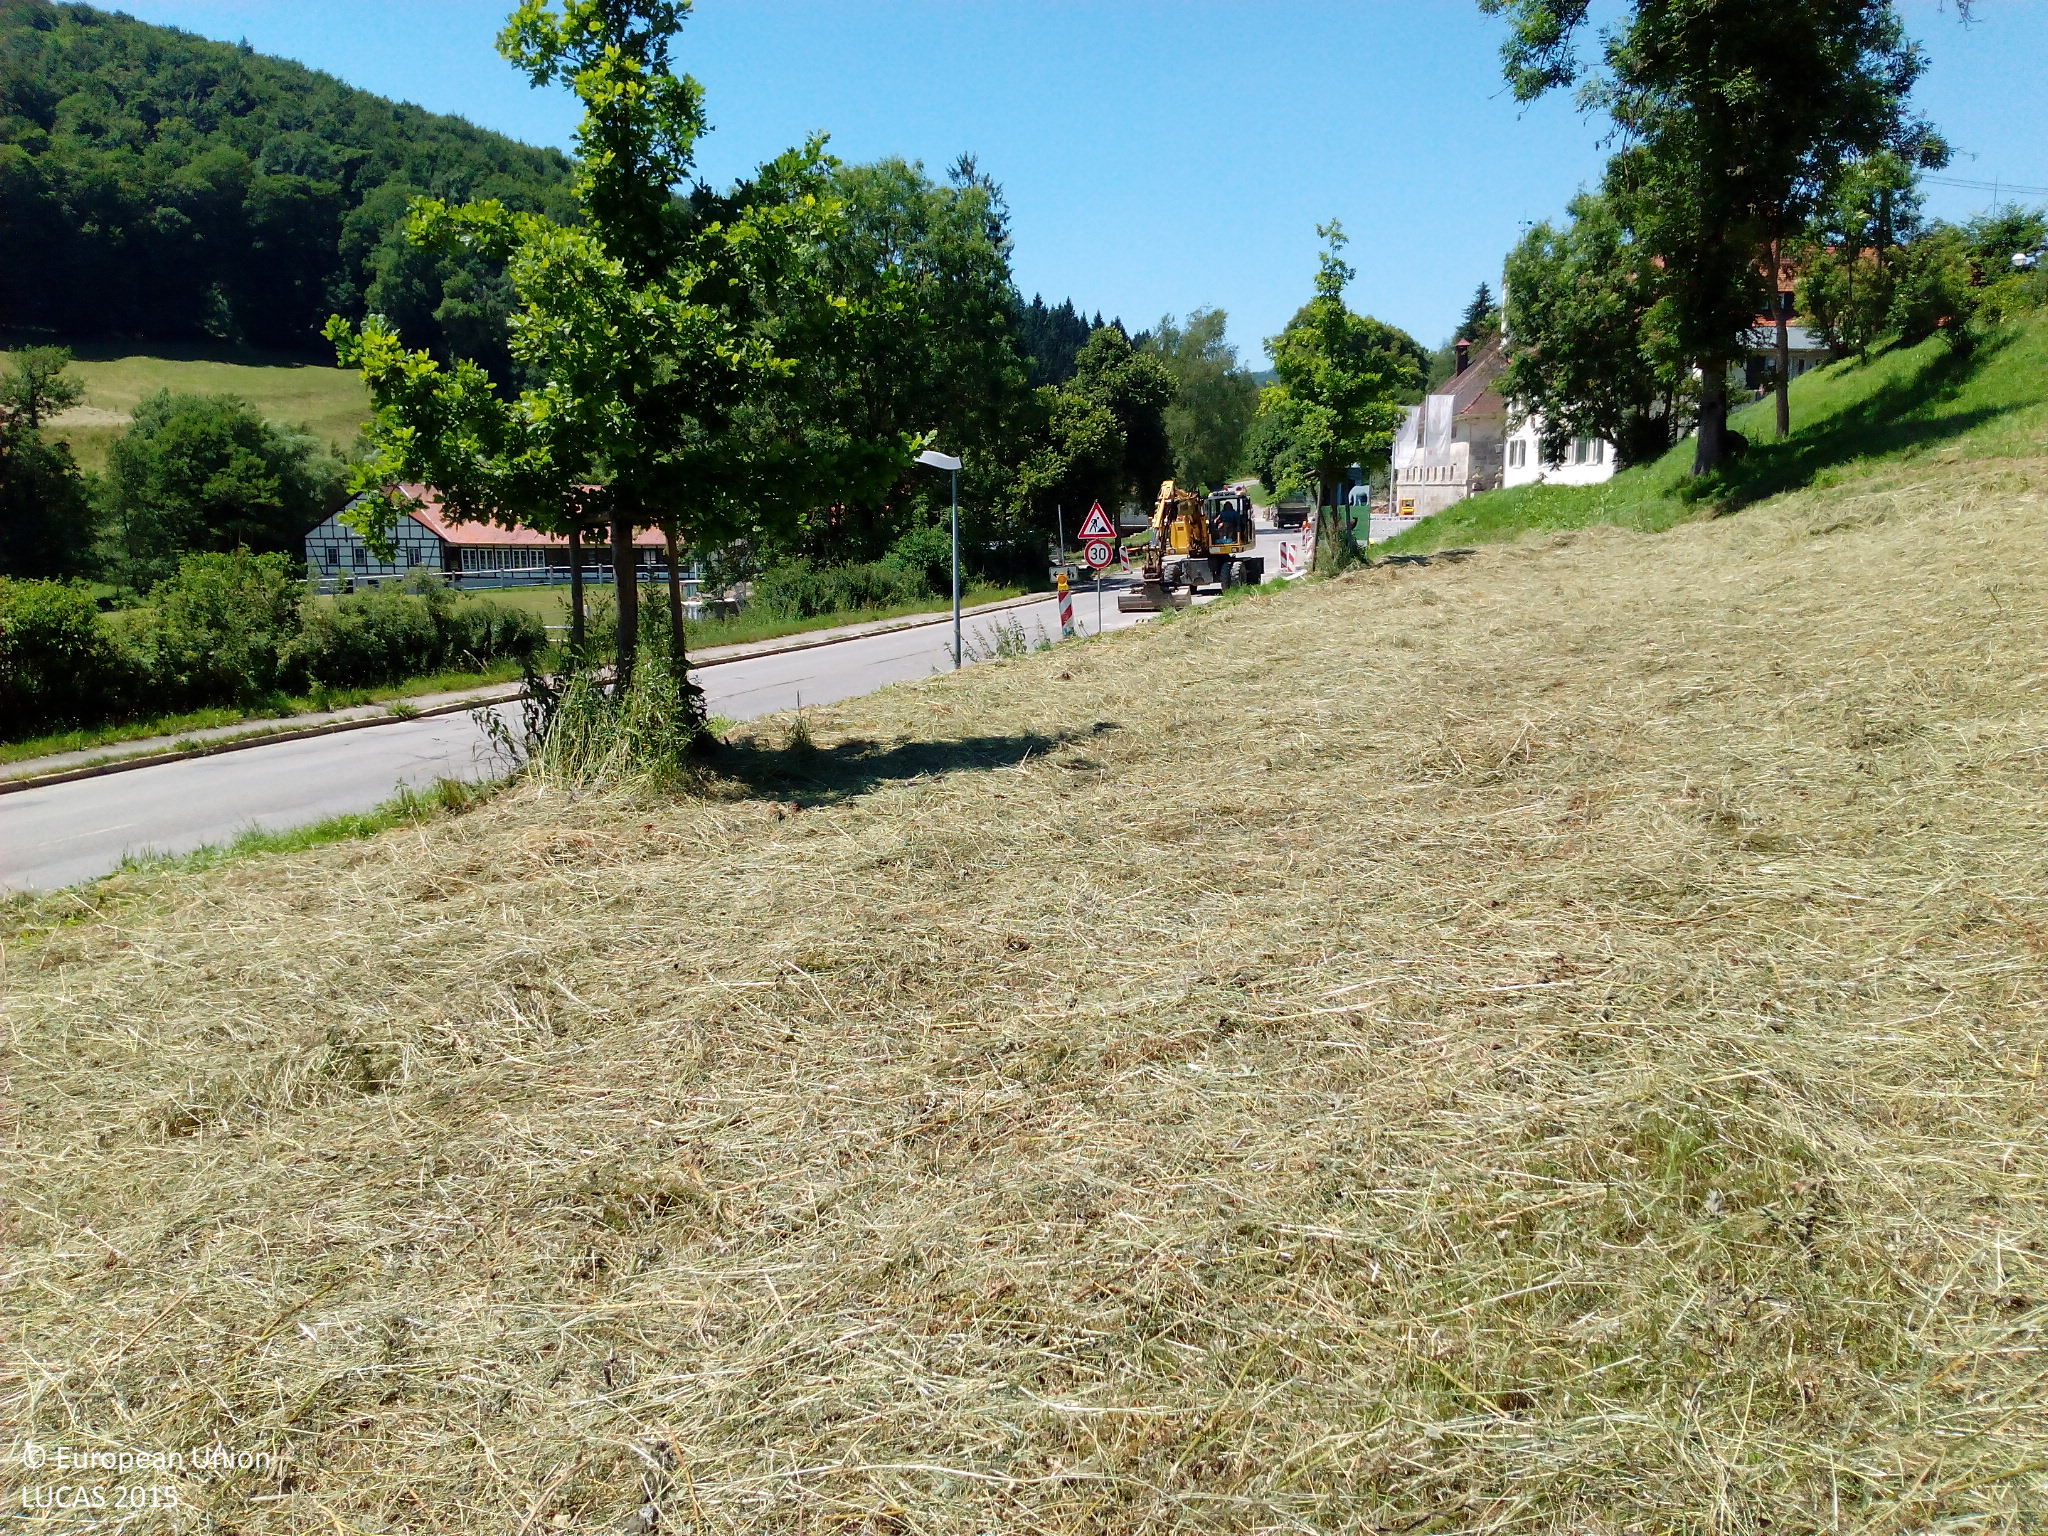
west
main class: Grassland
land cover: Grassland without tree/shrub cover
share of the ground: > 75 %
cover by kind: herbaceous plants 100 %
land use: Agriculture (excluding fallow land and kitchen gardens)
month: July
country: DE
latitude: 48.3840
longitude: 9.4197
